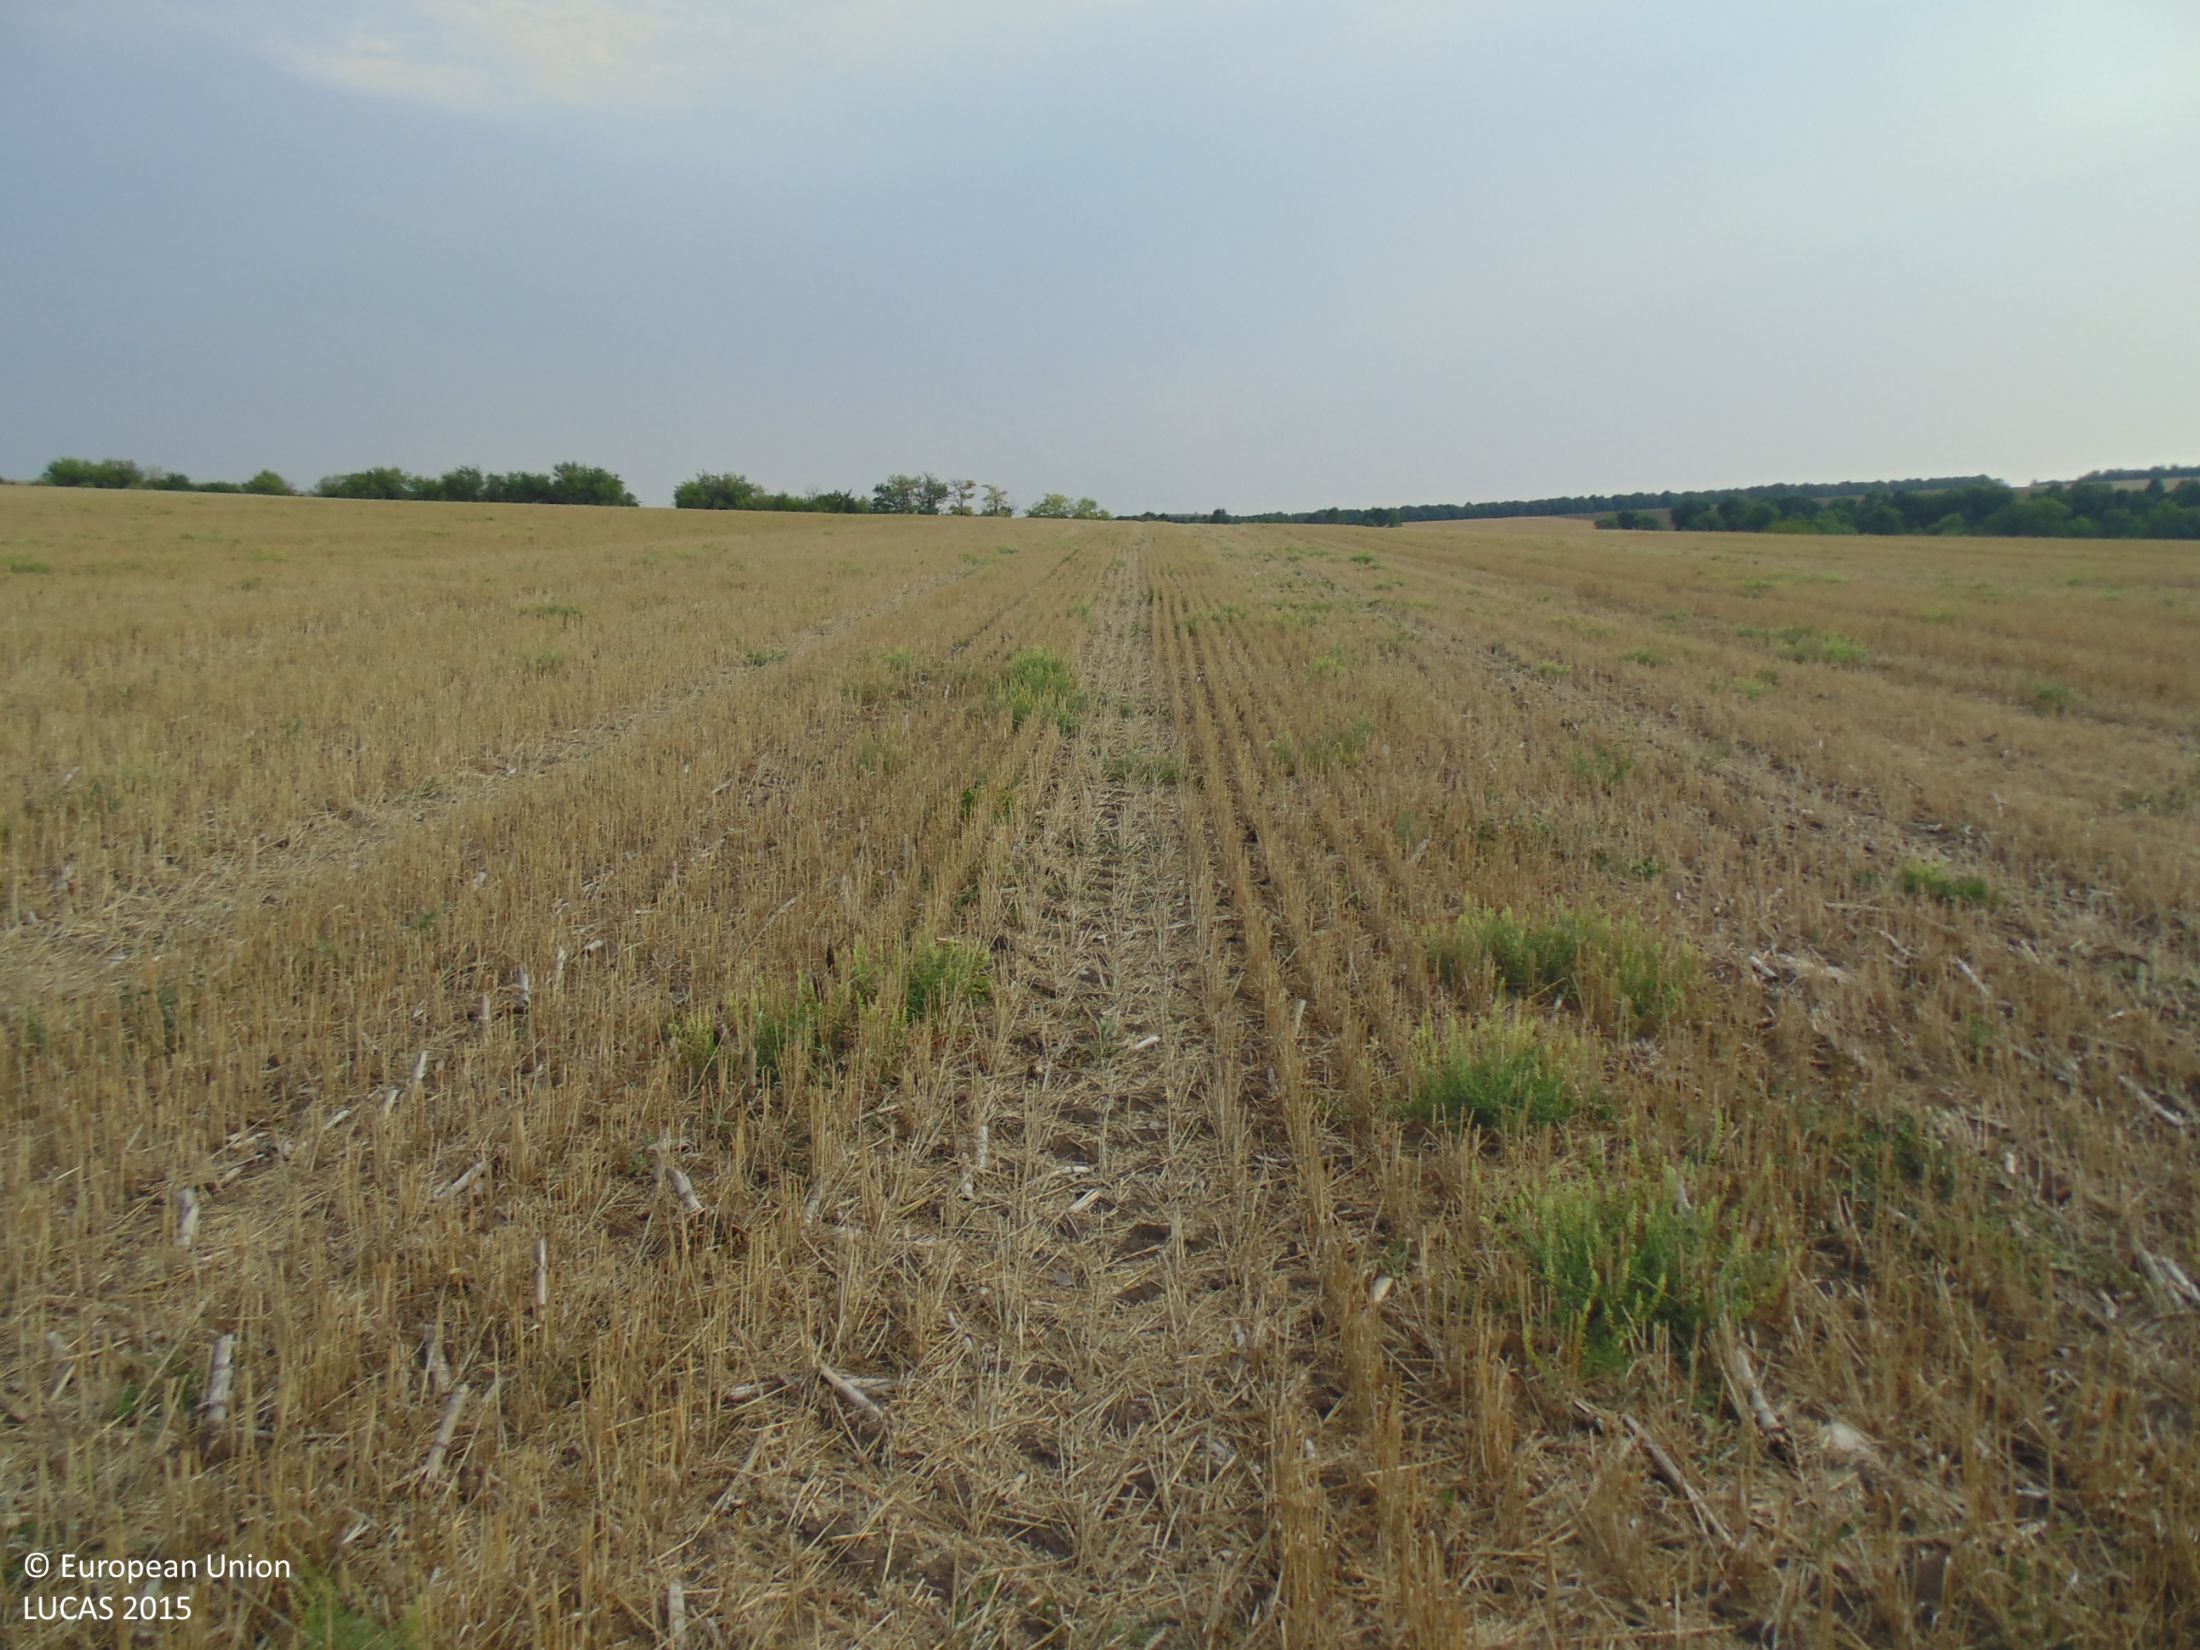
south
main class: Cropland
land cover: Common wheat
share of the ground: 25 - 50 %
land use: Agriculture (excluding fallow land and kitchen gardens)
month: August
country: BG
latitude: 43.6246
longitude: 27.5971
